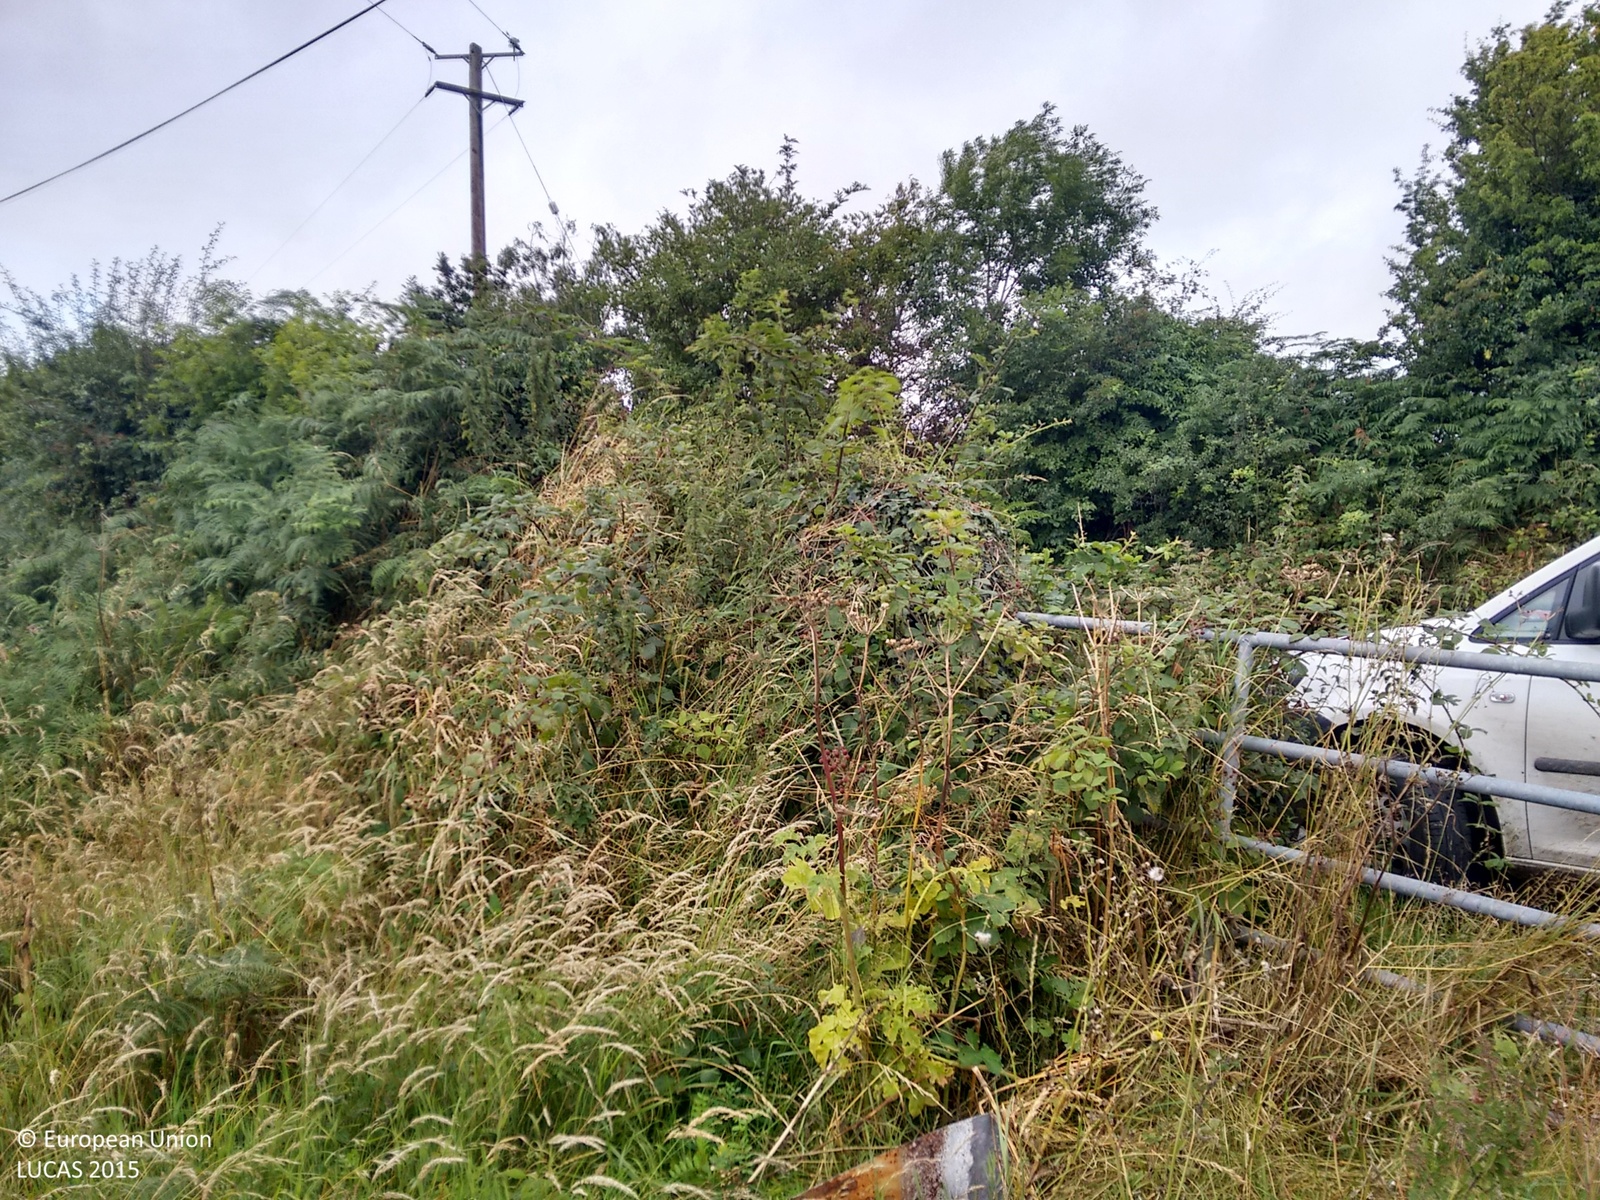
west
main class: Cropland
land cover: Oats
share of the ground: > 75 %
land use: Agriculture (excluding fallow land and kitchen gardens)
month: August
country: IE
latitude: 52.5210
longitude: -6.5927
